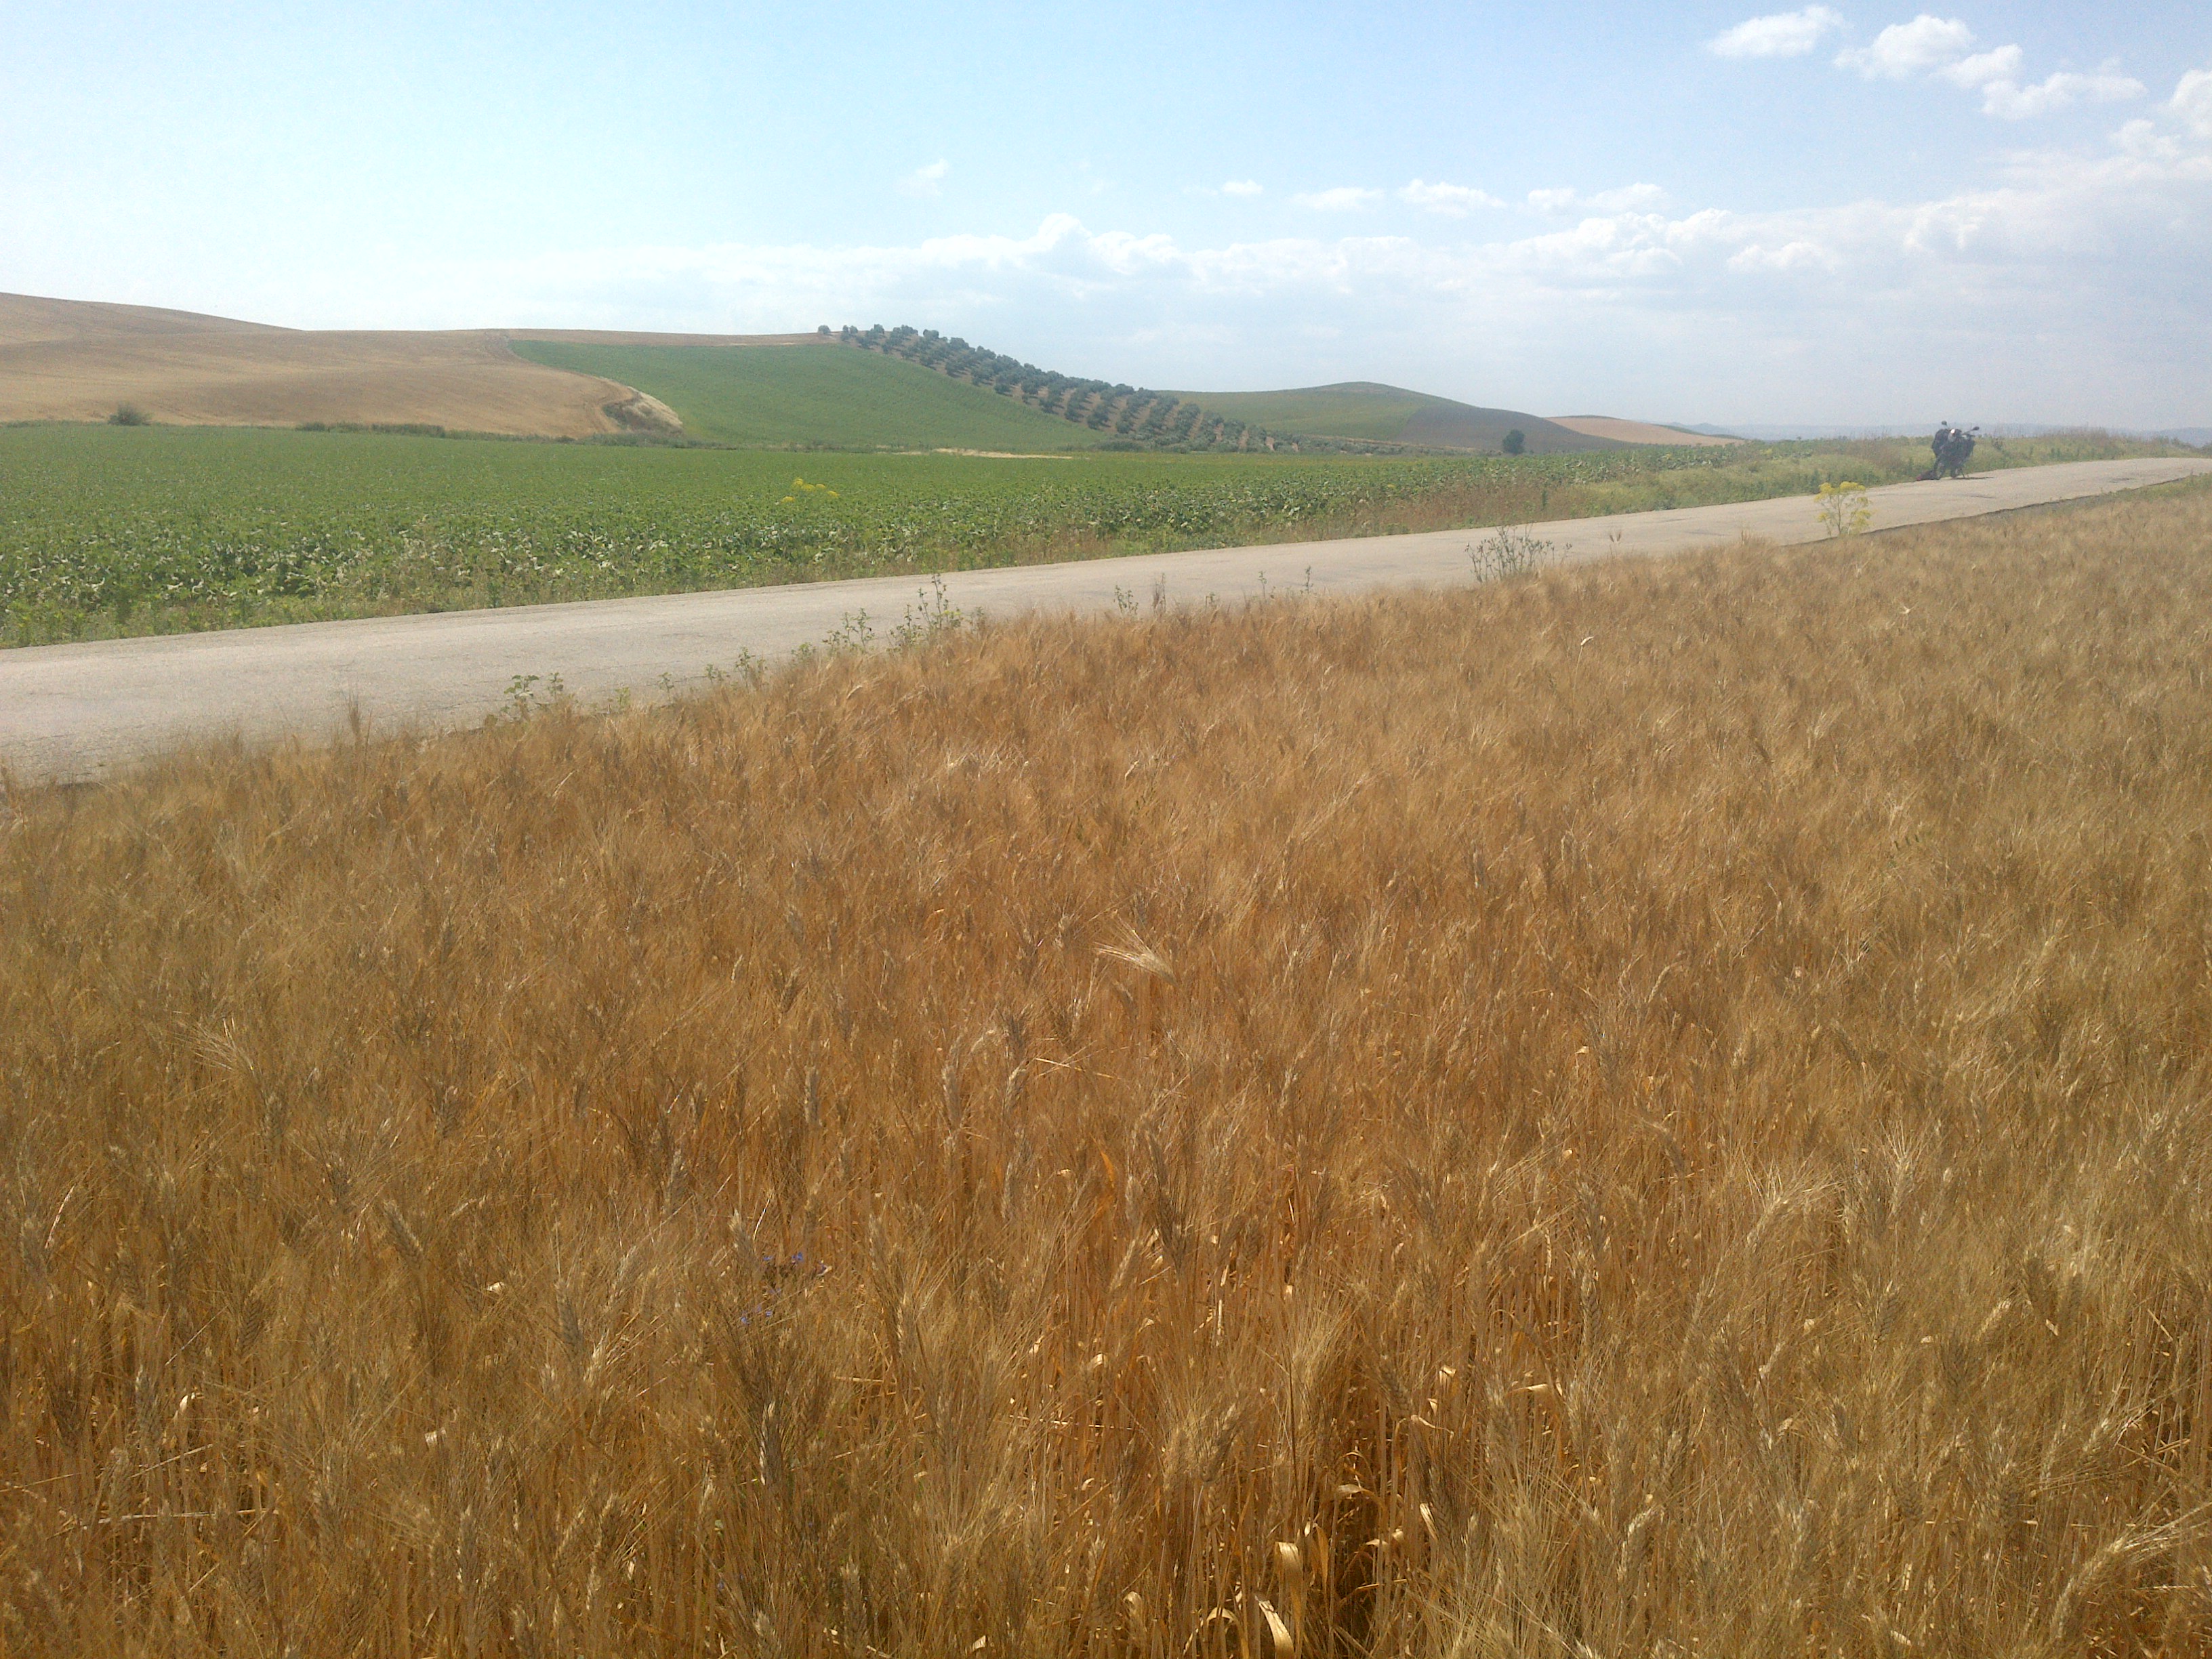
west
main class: Cropland
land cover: Durum wheat
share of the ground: > 75 %
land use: Agriculture (excluding fallow land and kitchen gardens)
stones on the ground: 10 - 25 %
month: May
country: ES
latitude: 37.8502
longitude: -4.4543
